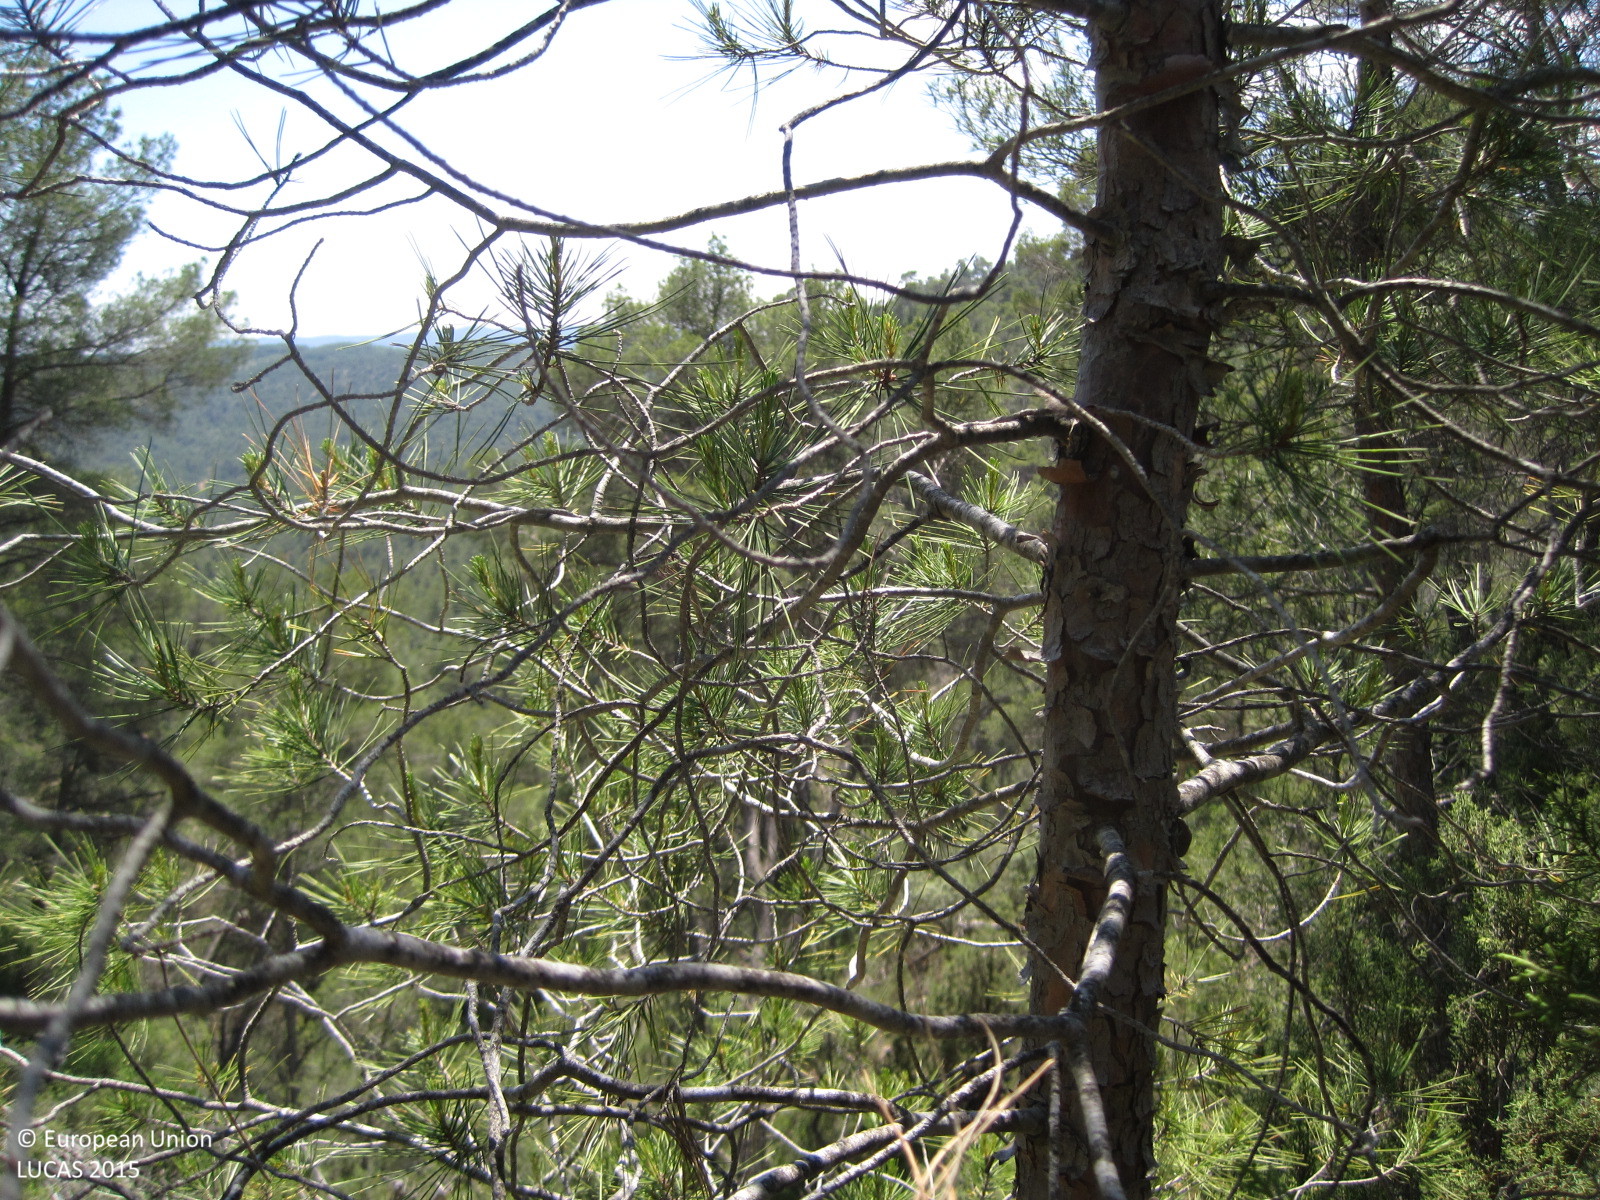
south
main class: Woodland
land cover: Pine dominated coniferous woodland
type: coniferous forest of the mediterranean region
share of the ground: 25 - 50 %
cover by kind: coniferous forest trees 40 %, shrubs 35 %, consolidated bare surface 15 %, herbaceous plants 10 %
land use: Forestry
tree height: > 5 m
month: June
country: ES
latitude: 39.7725
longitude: -1.1776
